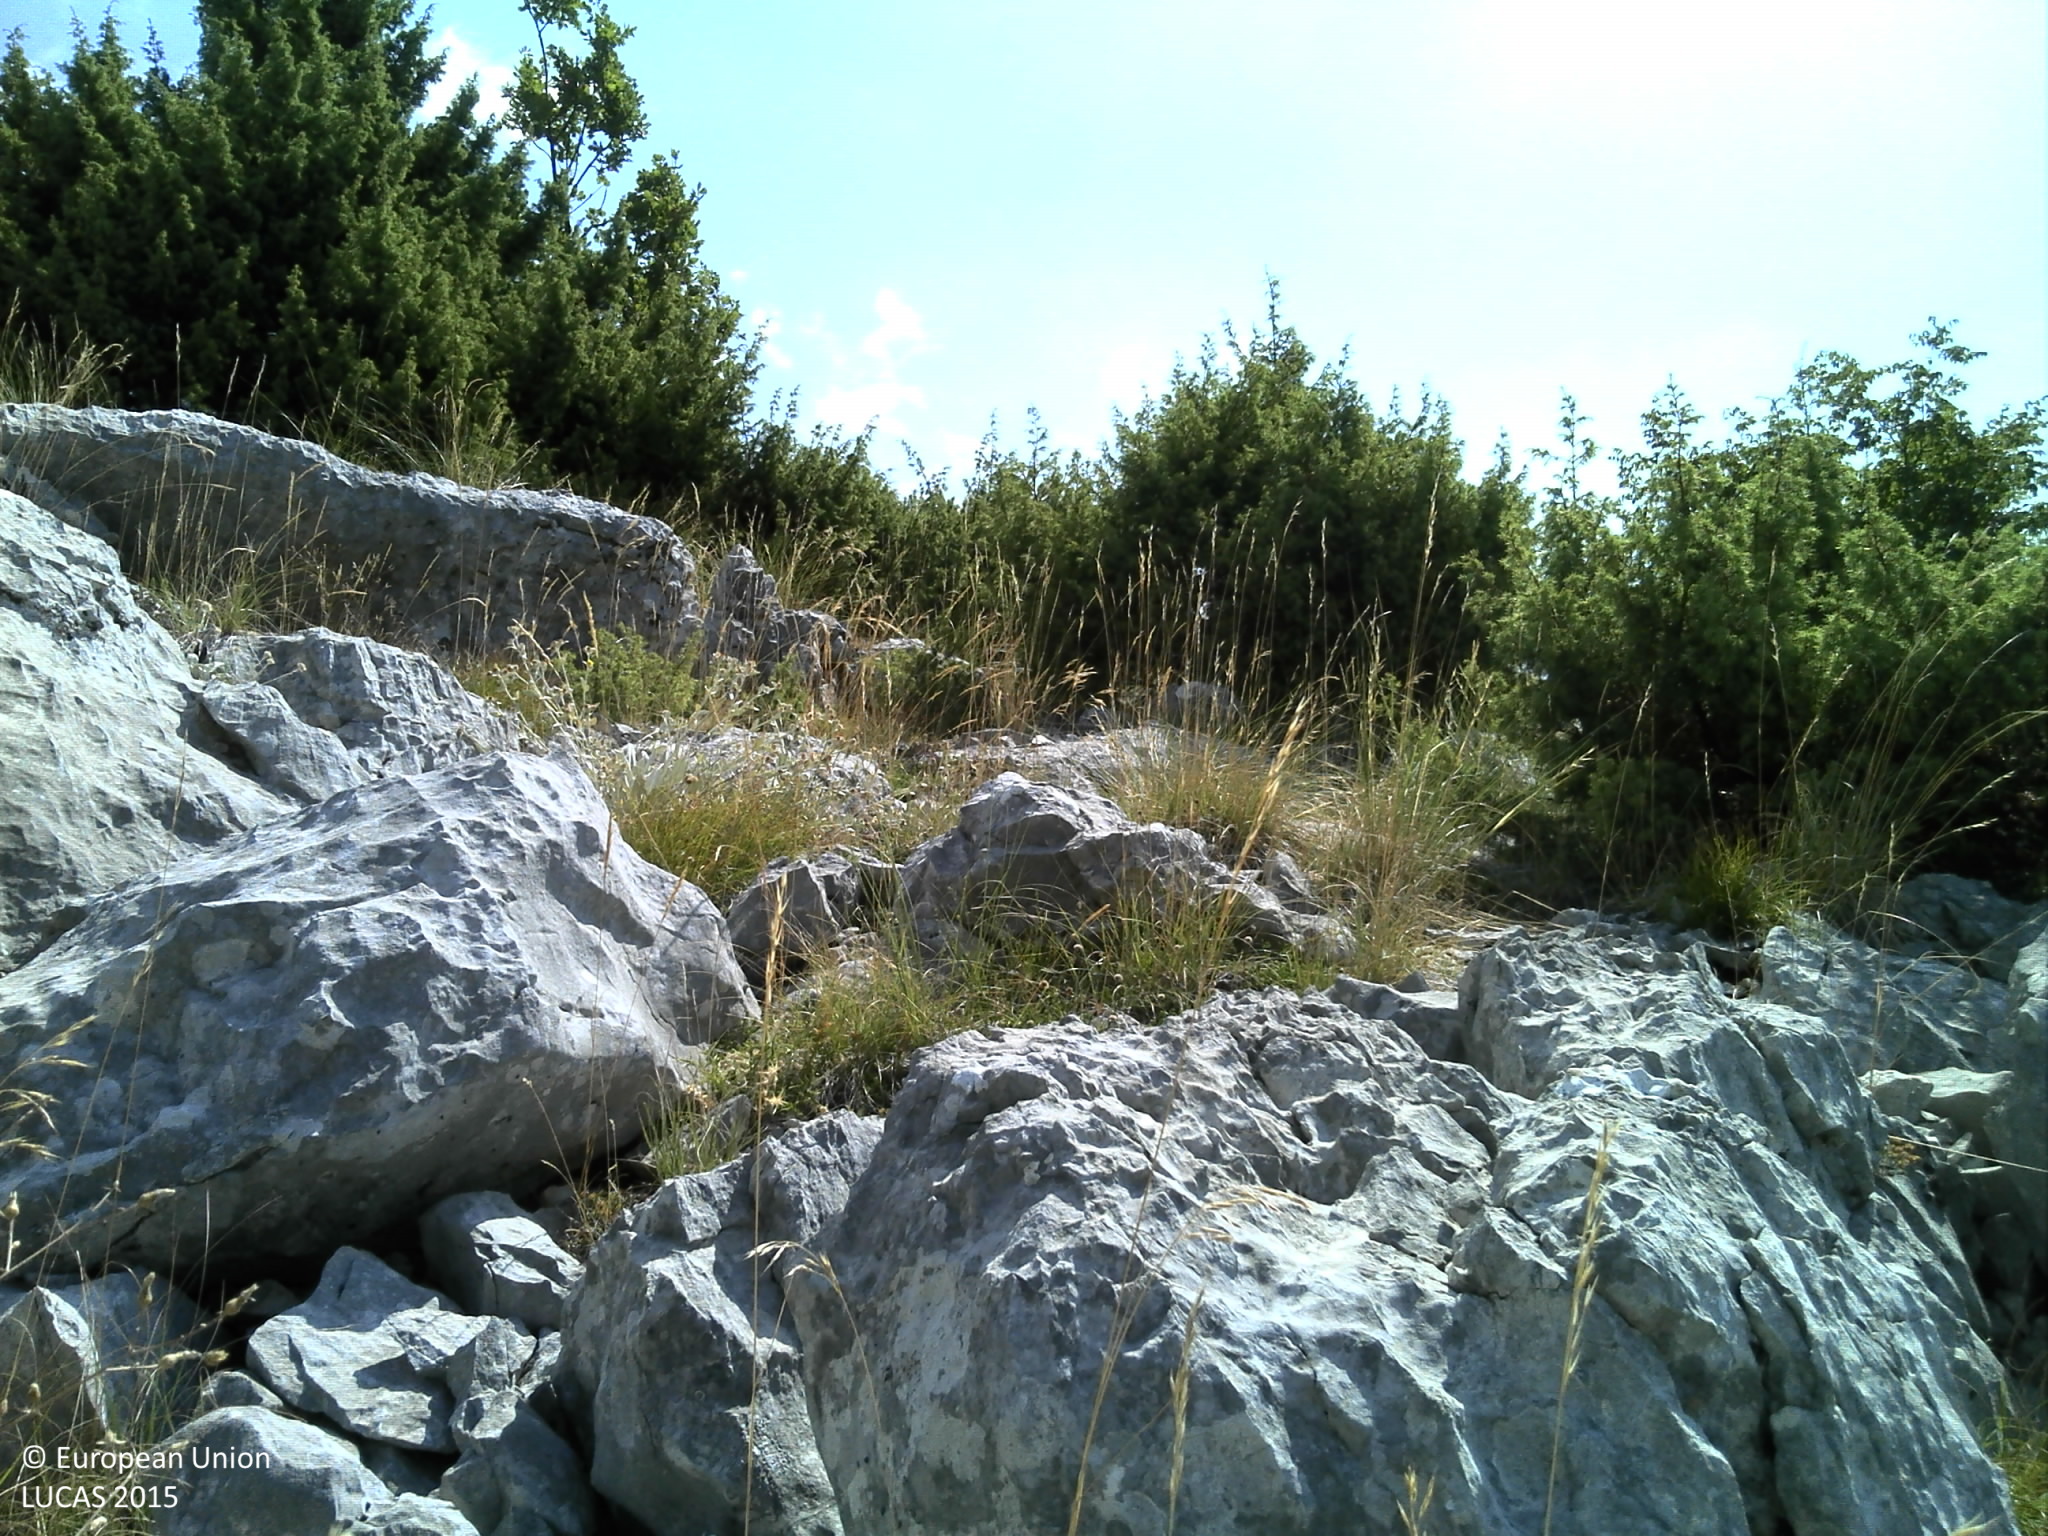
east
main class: Shrubland
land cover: Shrubland with sparse tree cover
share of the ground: > 75 %
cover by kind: shrubs 45 %, unconsolidated bare surface 25 %, herbaceous plants 20 %, coniferous forest trees 5 %, consolidated bare surface 5 %
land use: Semi-natural and natural areas not in use
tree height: < 5 m
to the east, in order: Shrubland with sparse tree cover; Rocks and stones; Shrubland with sparse tree cover; Dry stone walls; Shrubland with sparse tree cover; Dry stone walls; Shrubland with sparse tree cover
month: August
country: HR
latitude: 43.2622
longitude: 17.2719
